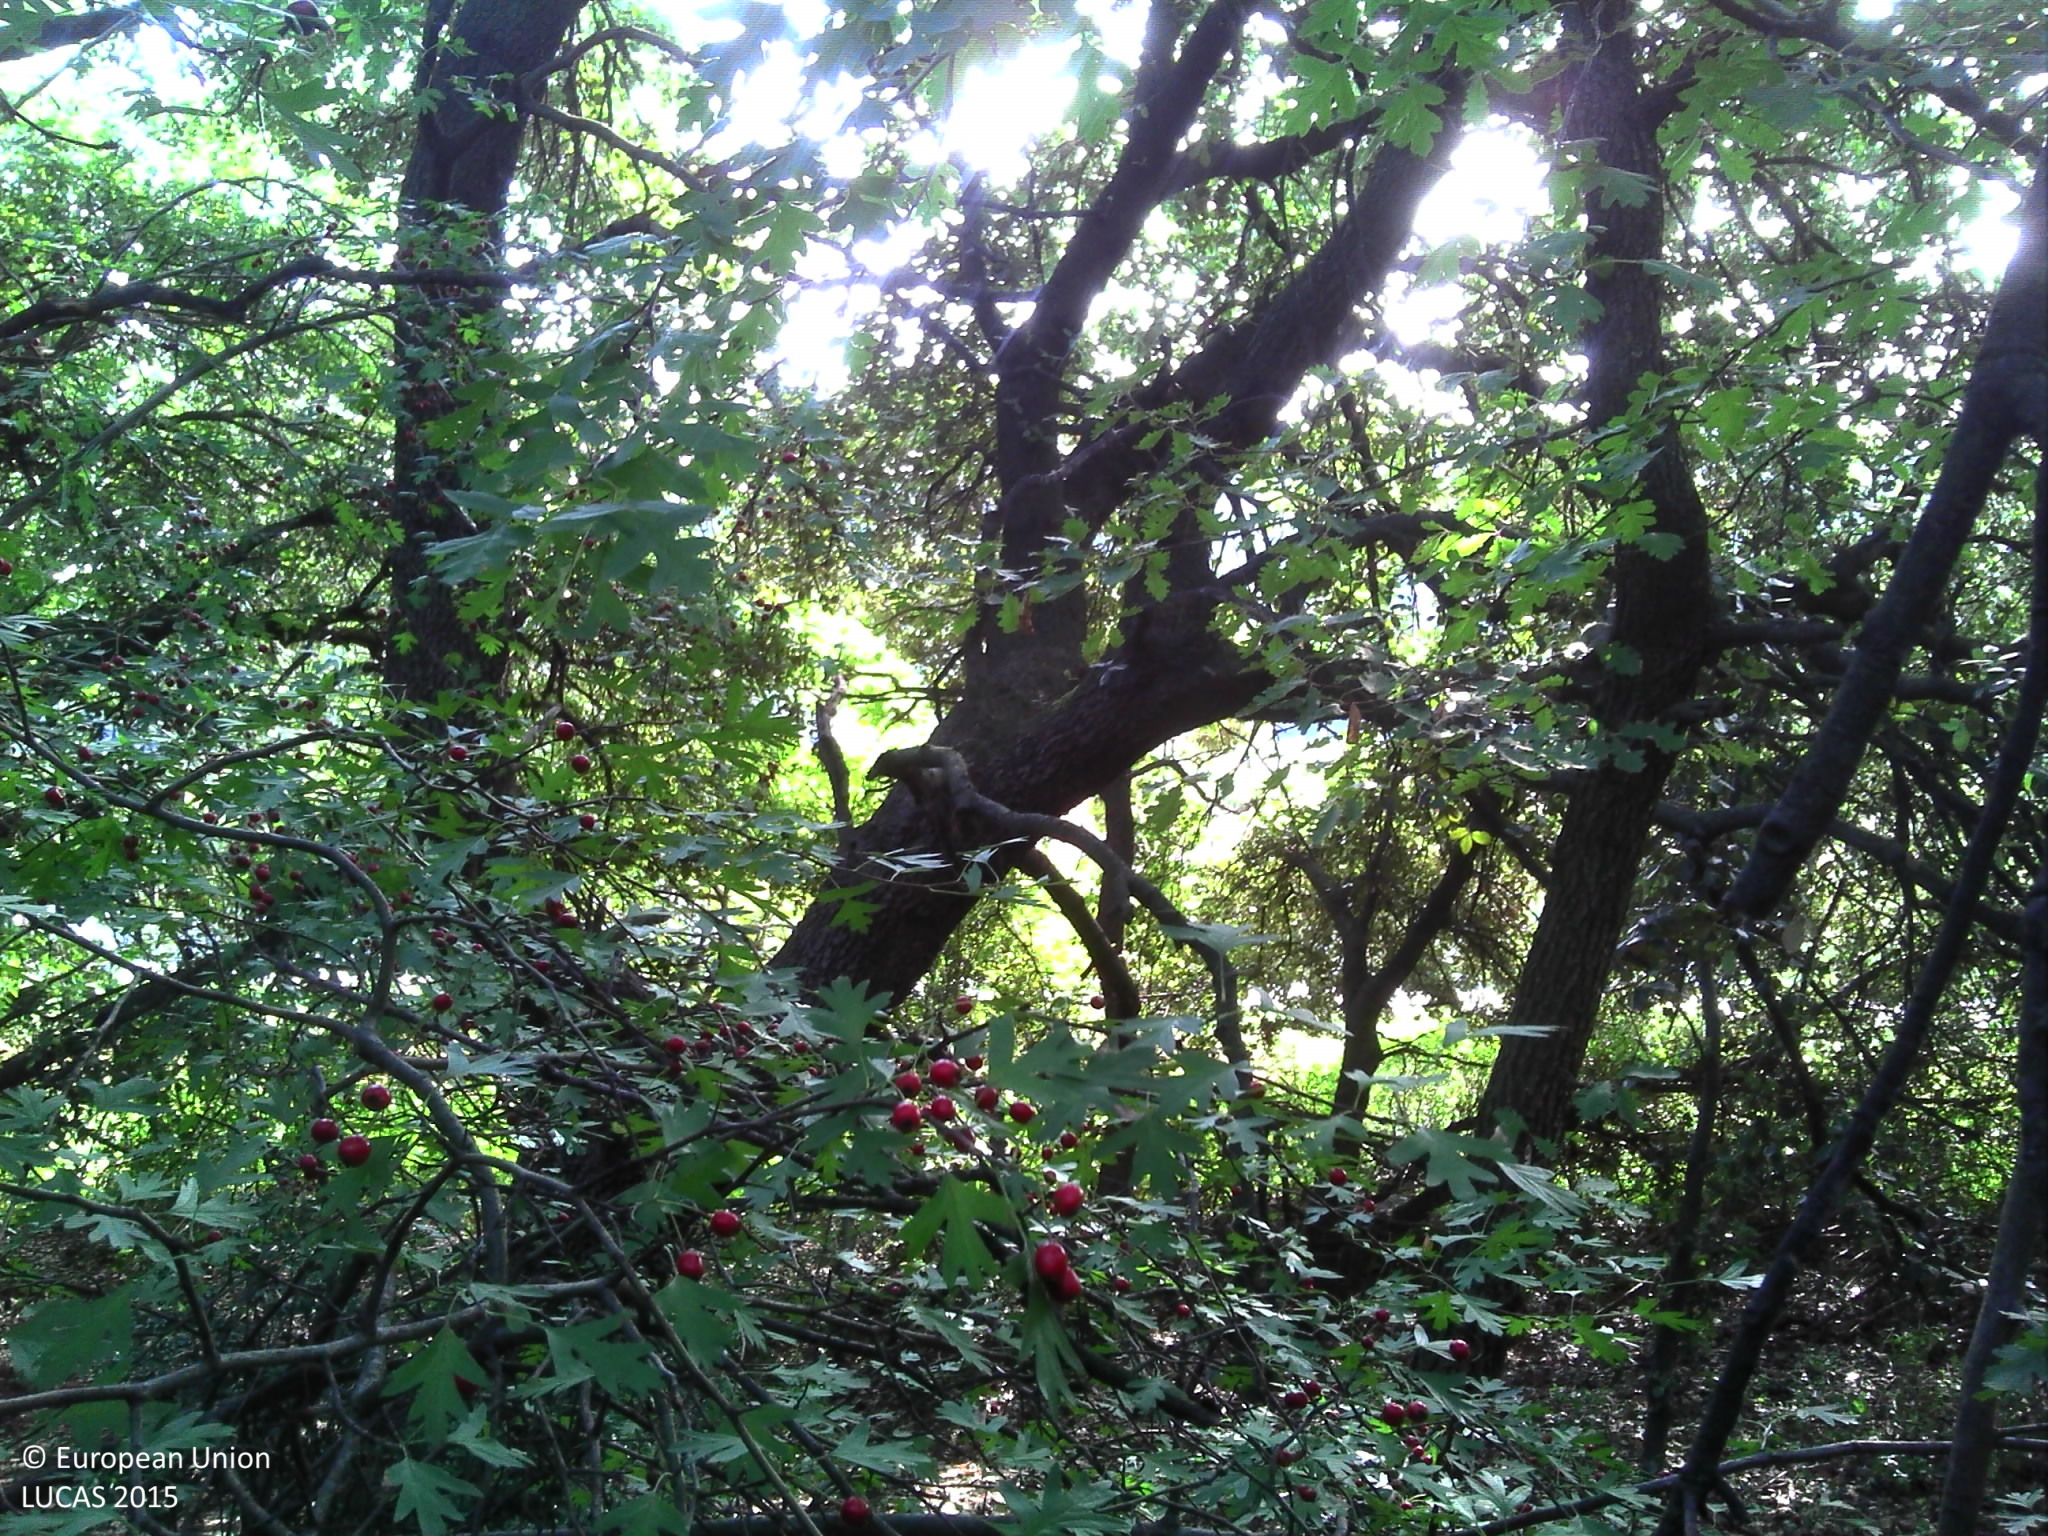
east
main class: Woodland
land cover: Broadleaved woodland
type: thermophilous deciduous forest
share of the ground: > 75 %
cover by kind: broadleaved forest trees 95 %, coniferous forest trees 5 %
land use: Semi-natural and natural areas not in use
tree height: > 5 m
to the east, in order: Broadleaved woodland; Fences; Grassland without tree/shrub cover; Ditches and canals; Grass margins; Paved roads, cycling and walking lanes; Grassland with sparse tree/shrub cover; Fences; Paved roads, cycling and walking lanes; Fences; Grassland with sparse tree/shrub cover; Tracks; Grassland without tree/shrub cover; Fences; Electric lines; Railways; Electric lines; Grassland with sparse tree/shrub cover; Fences; Ditches and canals; Grassland with sparse tree/shrub cover; Paved roads, cycling and walking lanes; Grassland with sparse tree/shrub cover; Tracks; Broadleaved woodland
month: September
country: FR
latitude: 44.4714
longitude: 4.7649
